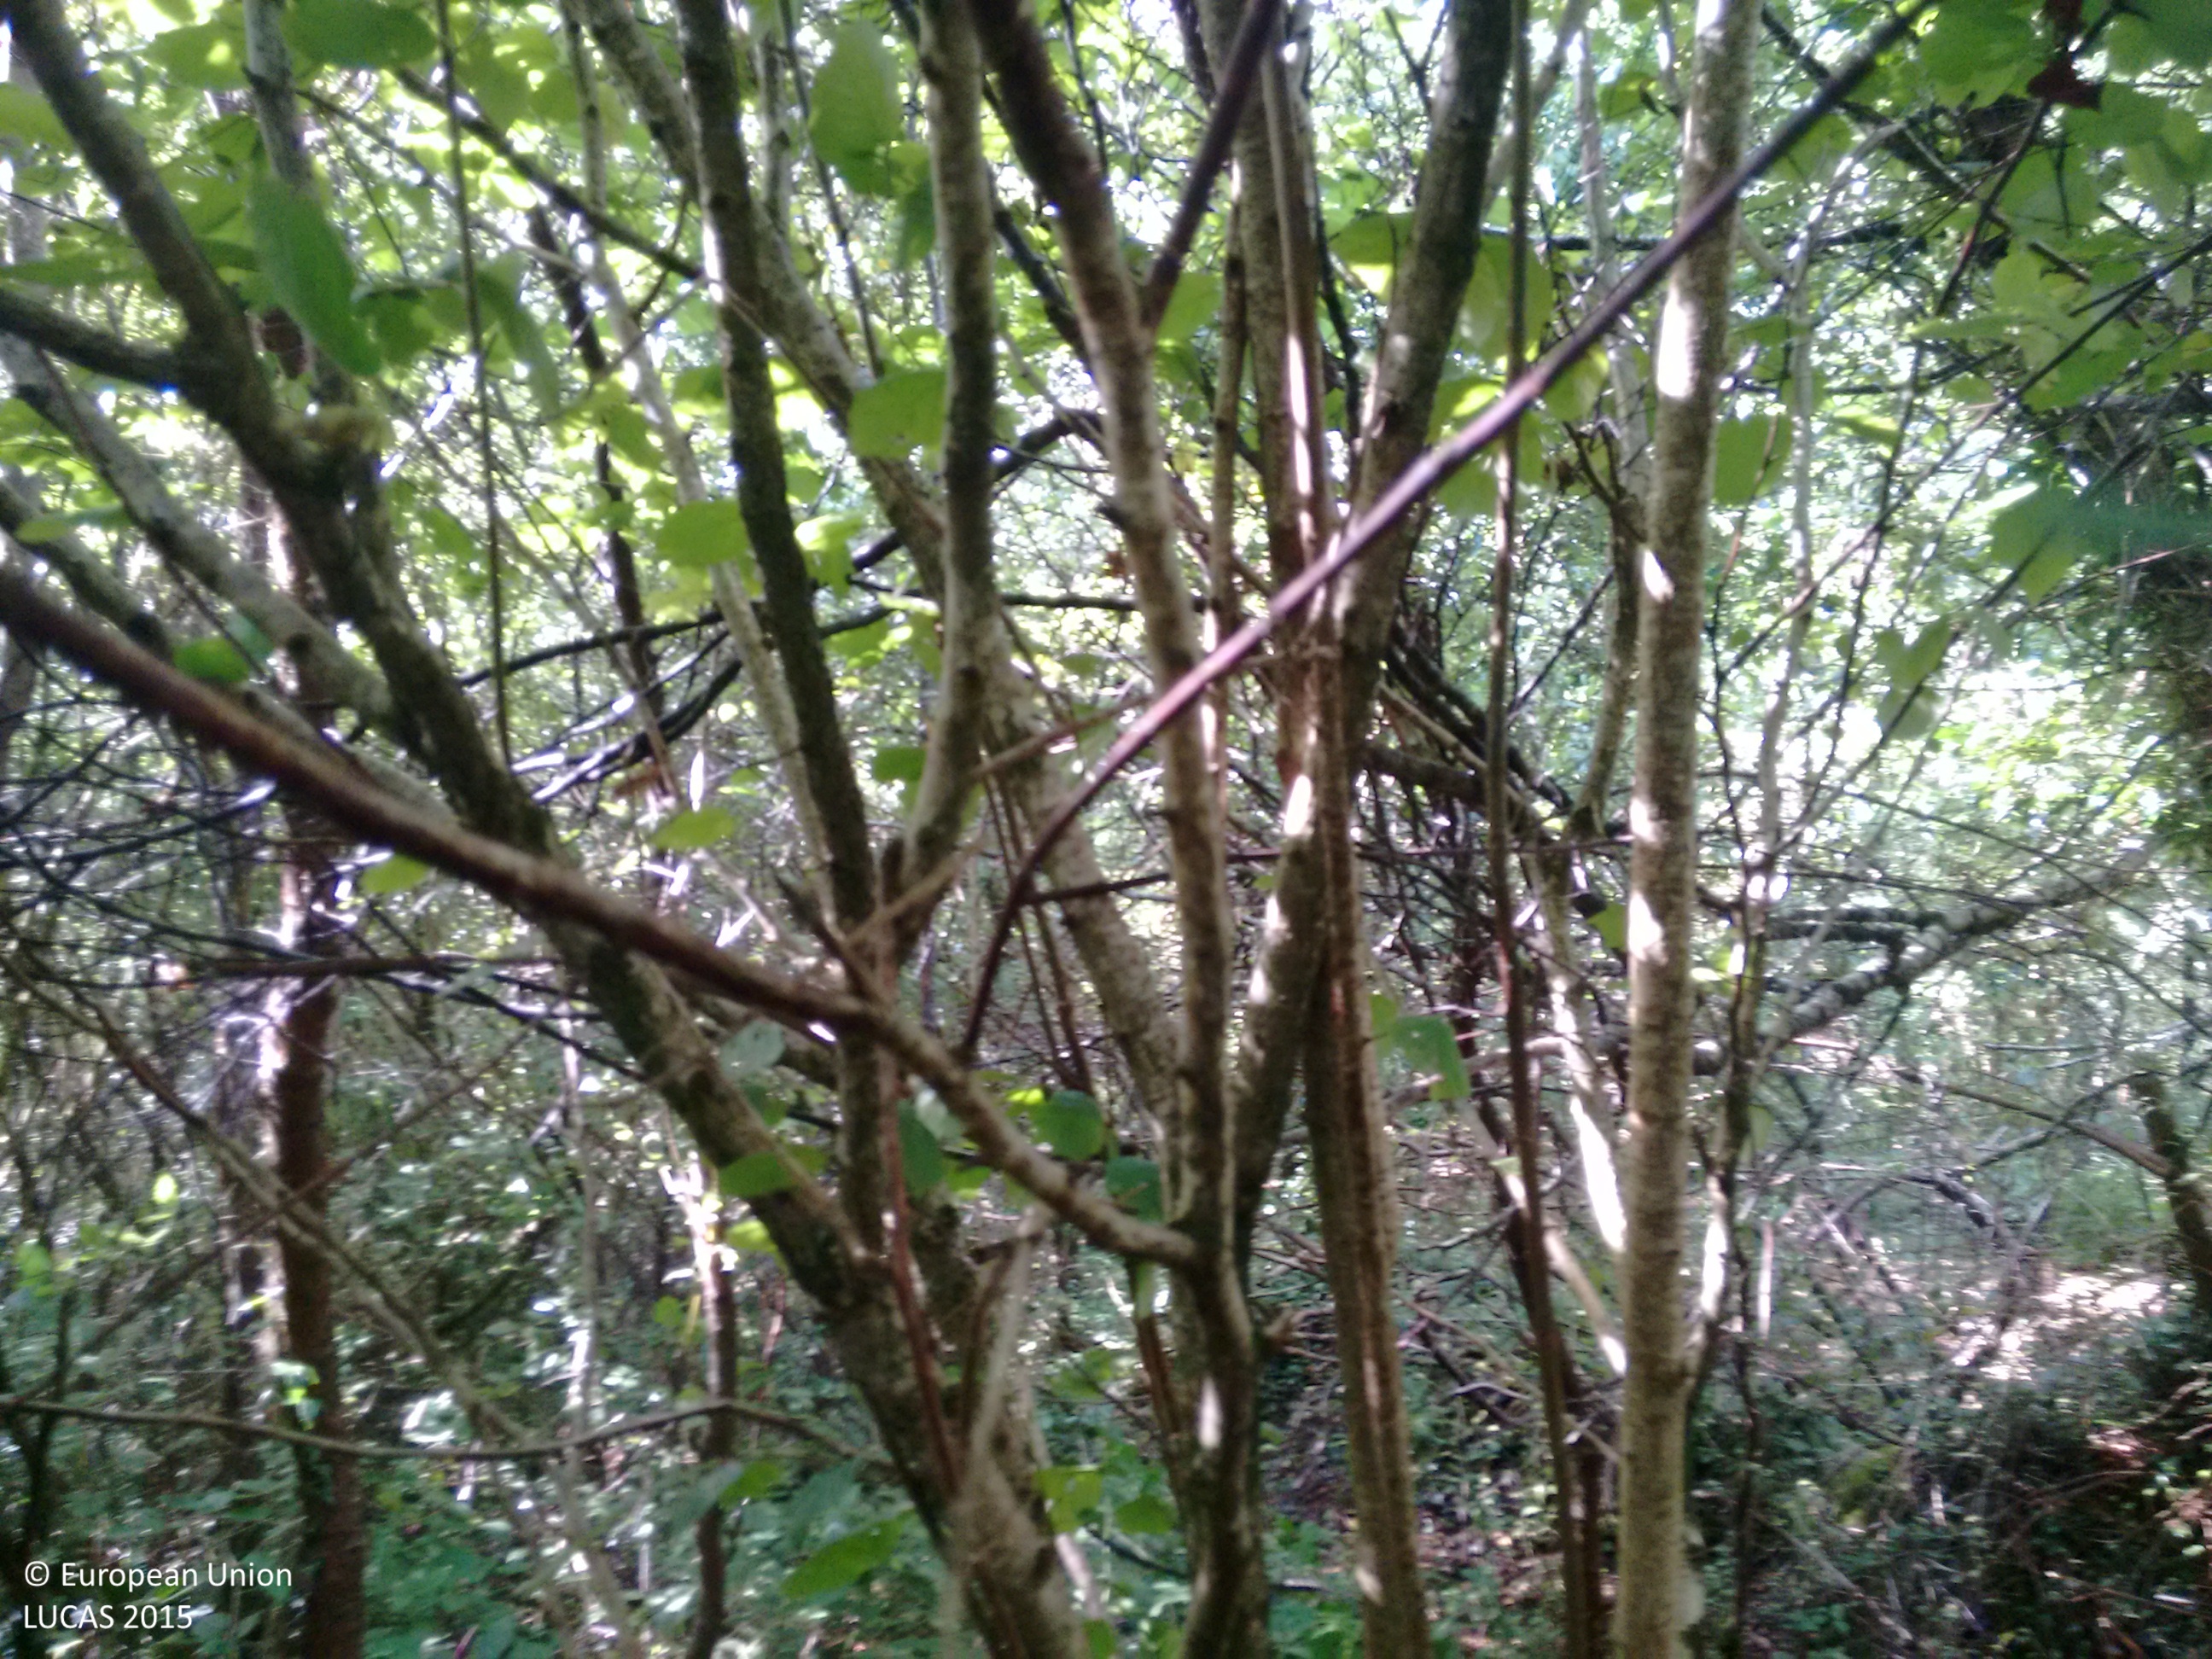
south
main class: Woodland
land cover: Broadleaved woodland
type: acidophilous oak and oak-birch forest
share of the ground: > 75 %
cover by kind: broadleaved forest trees 100 %
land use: Semi-natural and natural areas not in use
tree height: > 5 m
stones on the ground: < 10 %
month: August
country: IE
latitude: 51.8957
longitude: -9.5479
